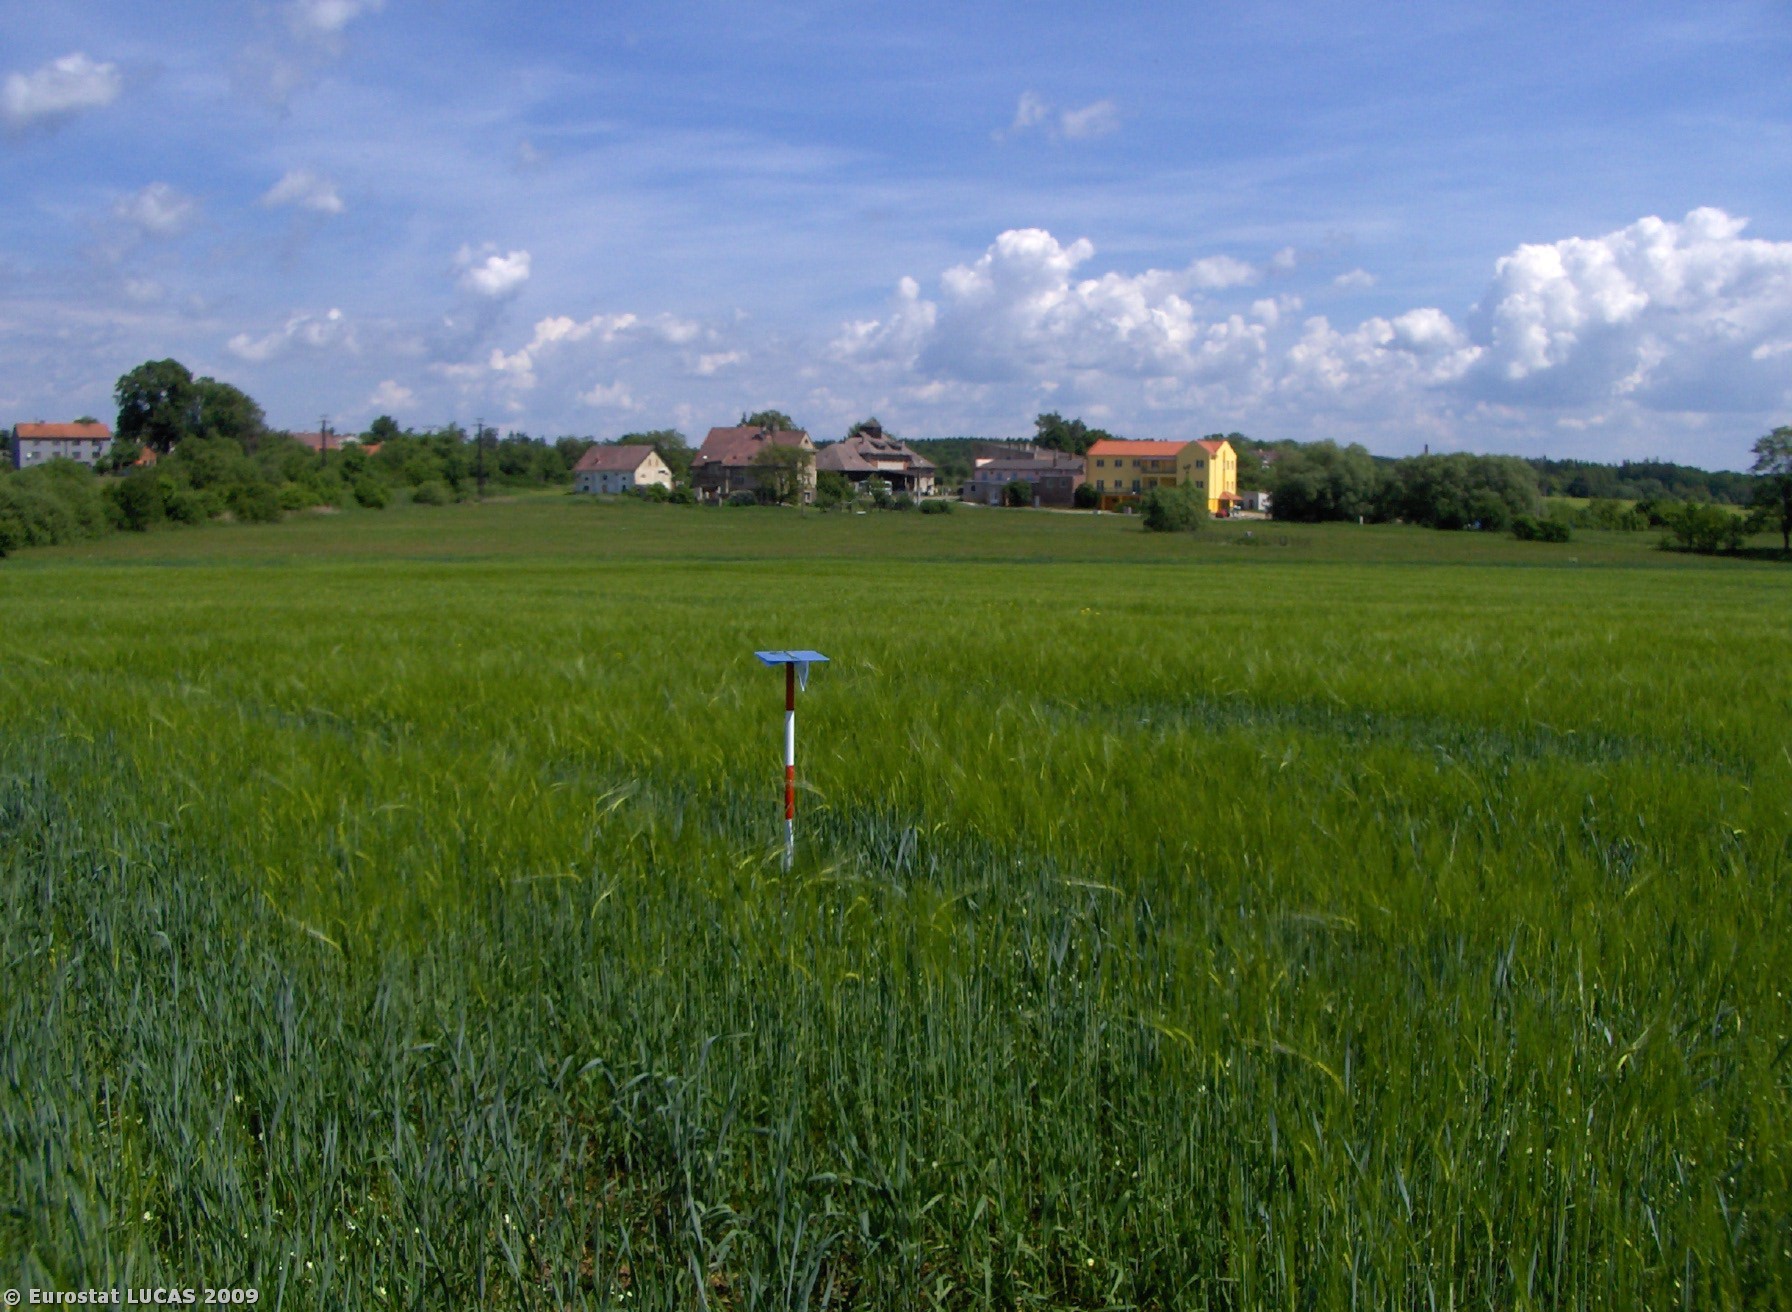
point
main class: Cropland
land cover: Barley
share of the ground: > 75 %
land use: Agriculture (excluding fallow land and kitchen gardens)
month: May
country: CZ
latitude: 49.3992
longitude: 14.3417
